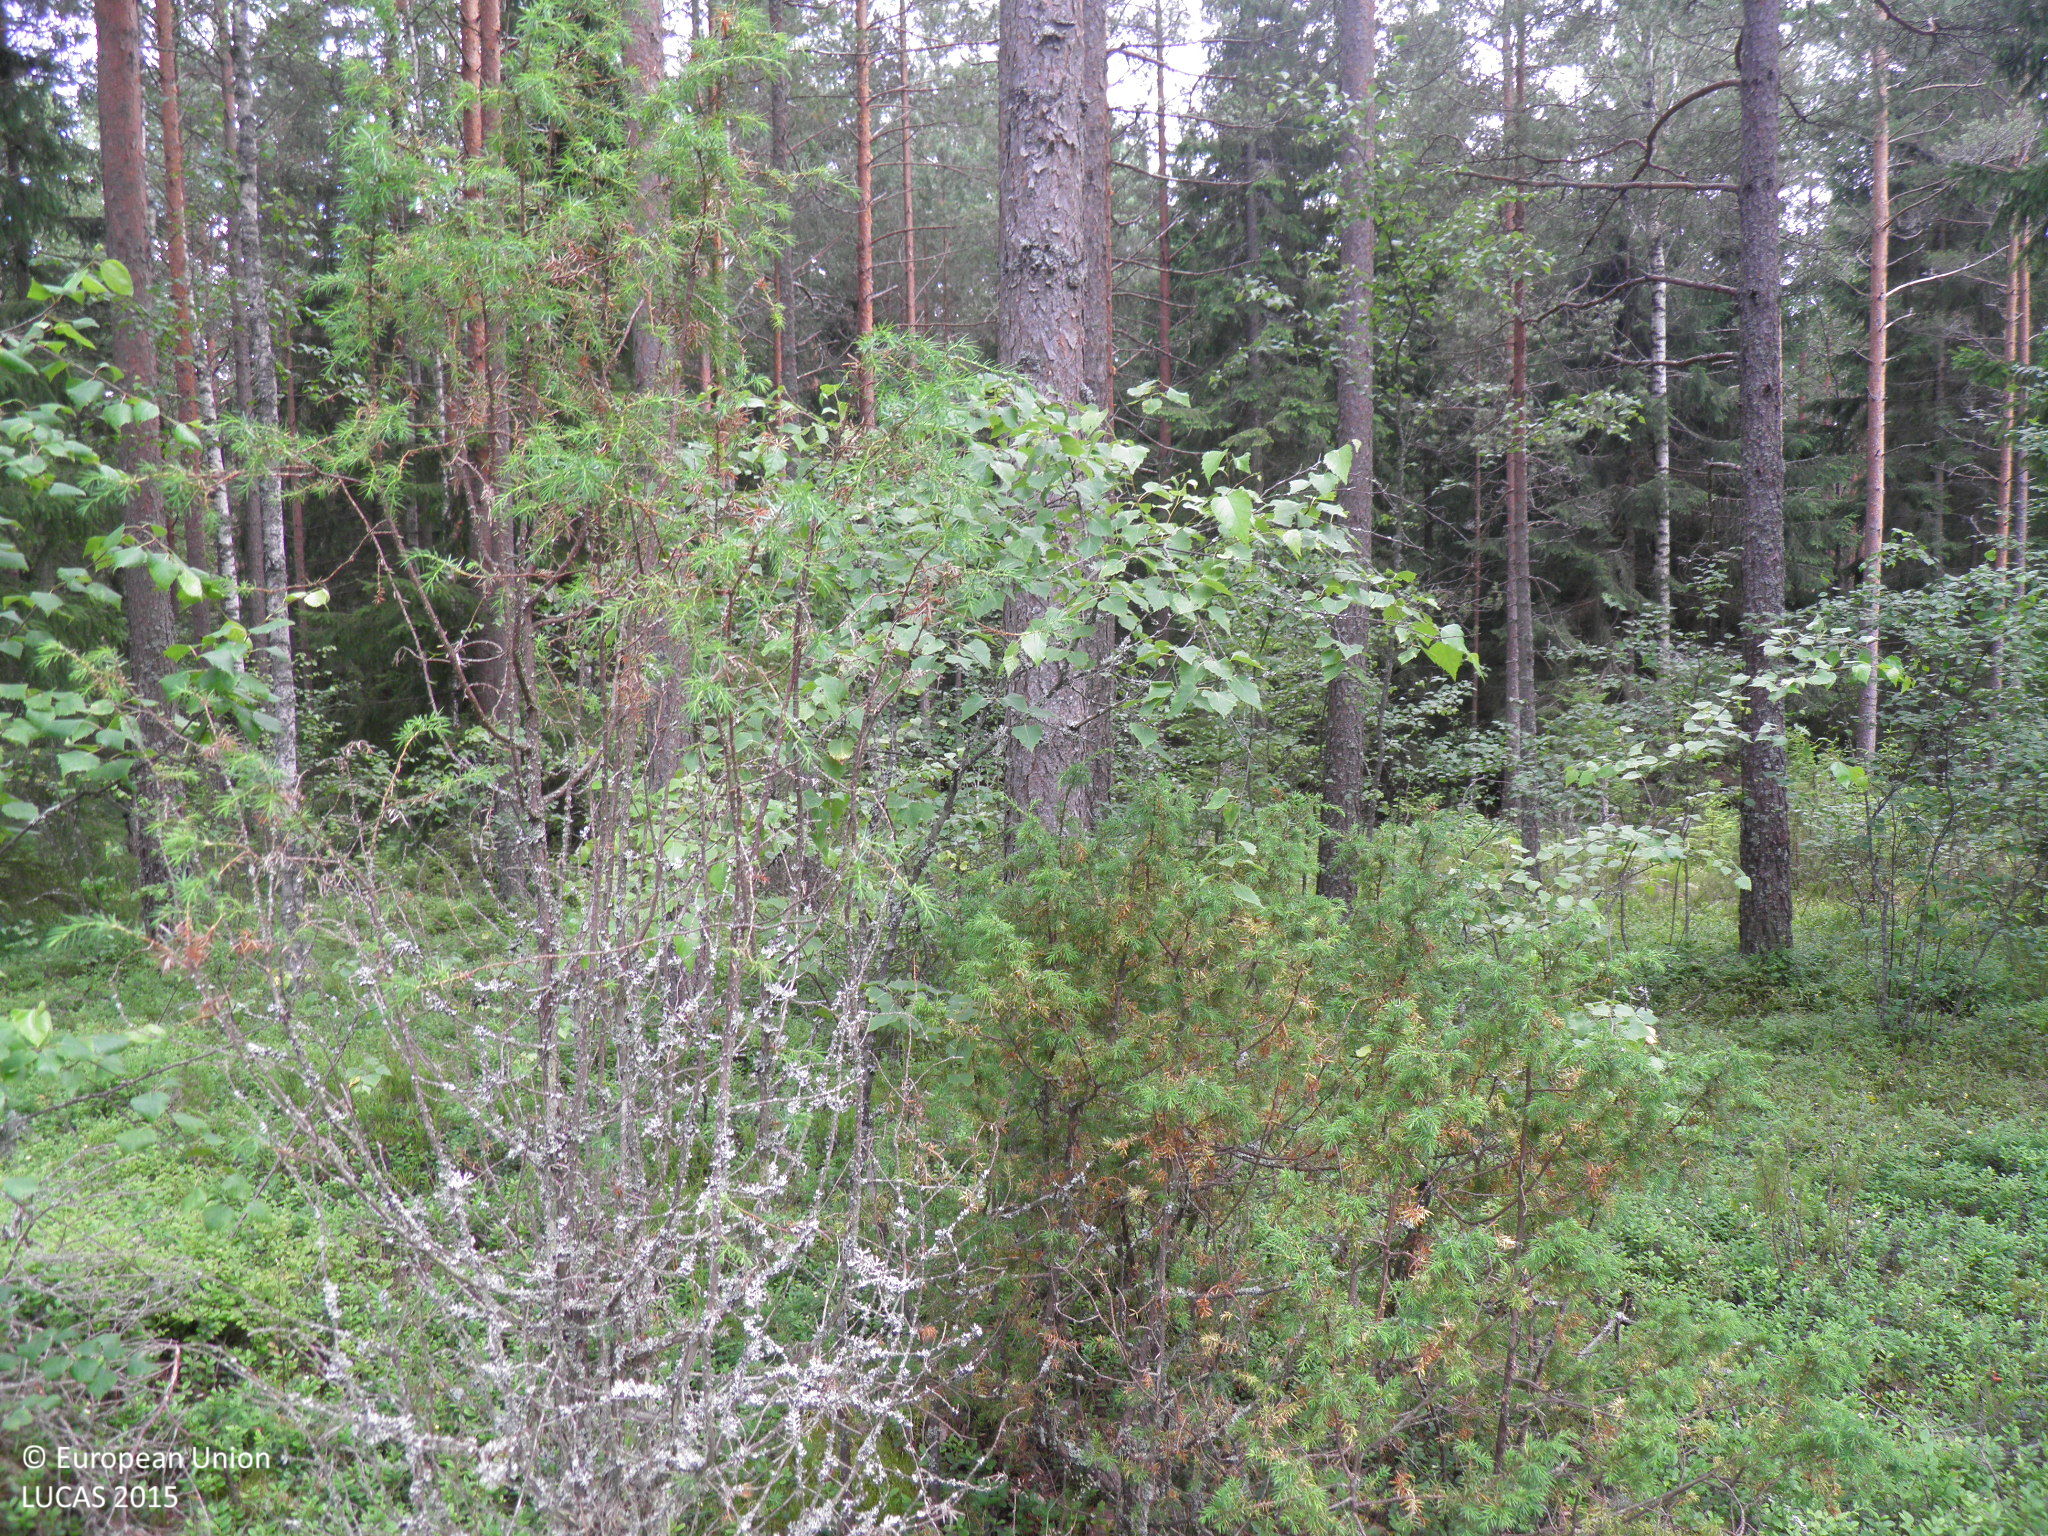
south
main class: Woodland
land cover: Pine dominated coniferous woodland
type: hemiboreal forest and nemoral coniferous forest and mixed broadleaved-coniferous forest
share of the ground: 25 - 50 %
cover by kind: shrubs 50 %, coniferous forest trees 25 %, herbaceous plants 20 %, broadleaved forest trees 5 %
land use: Forestry
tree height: > 5 m
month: July
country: FI
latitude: 60.0487
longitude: 22.6266
